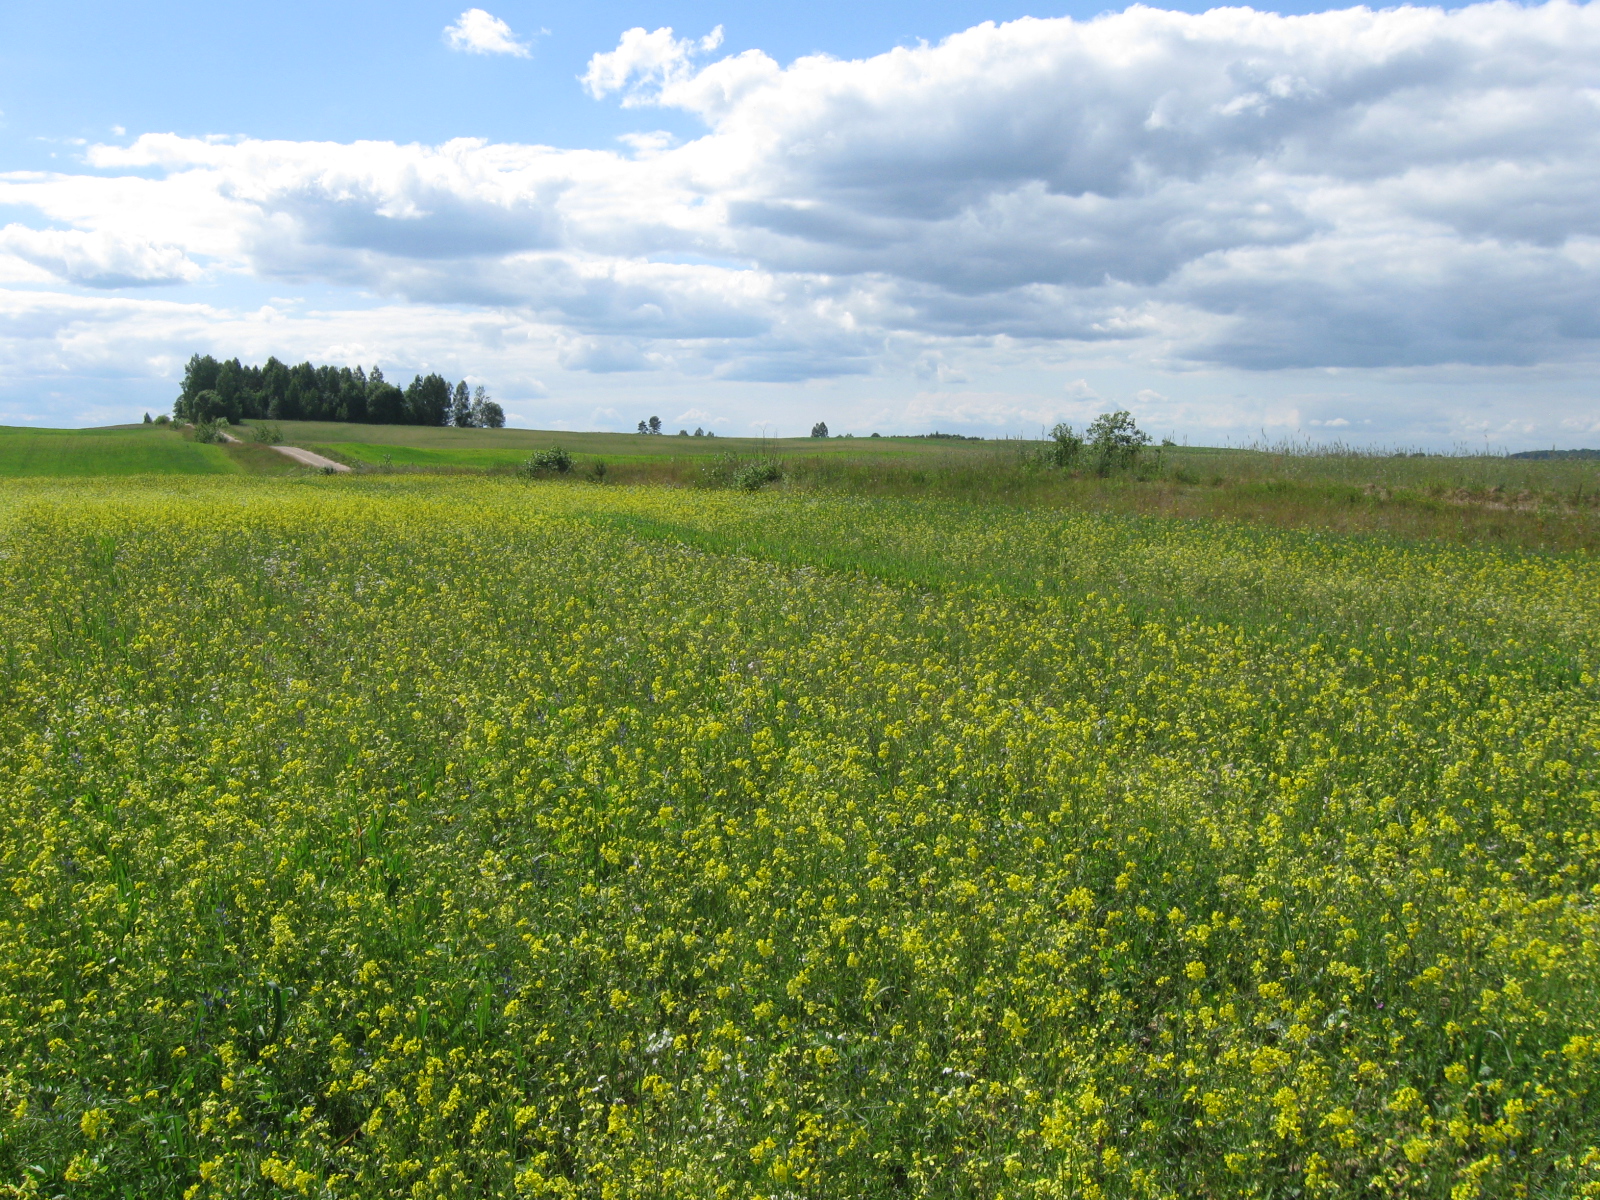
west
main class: Cropland
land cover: Dry pulses
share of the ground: > 75 %
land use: Agriculture (excluding fallow land and kitchen gardens)
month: June
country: LT
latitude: 54.5211
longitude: 24.6125
